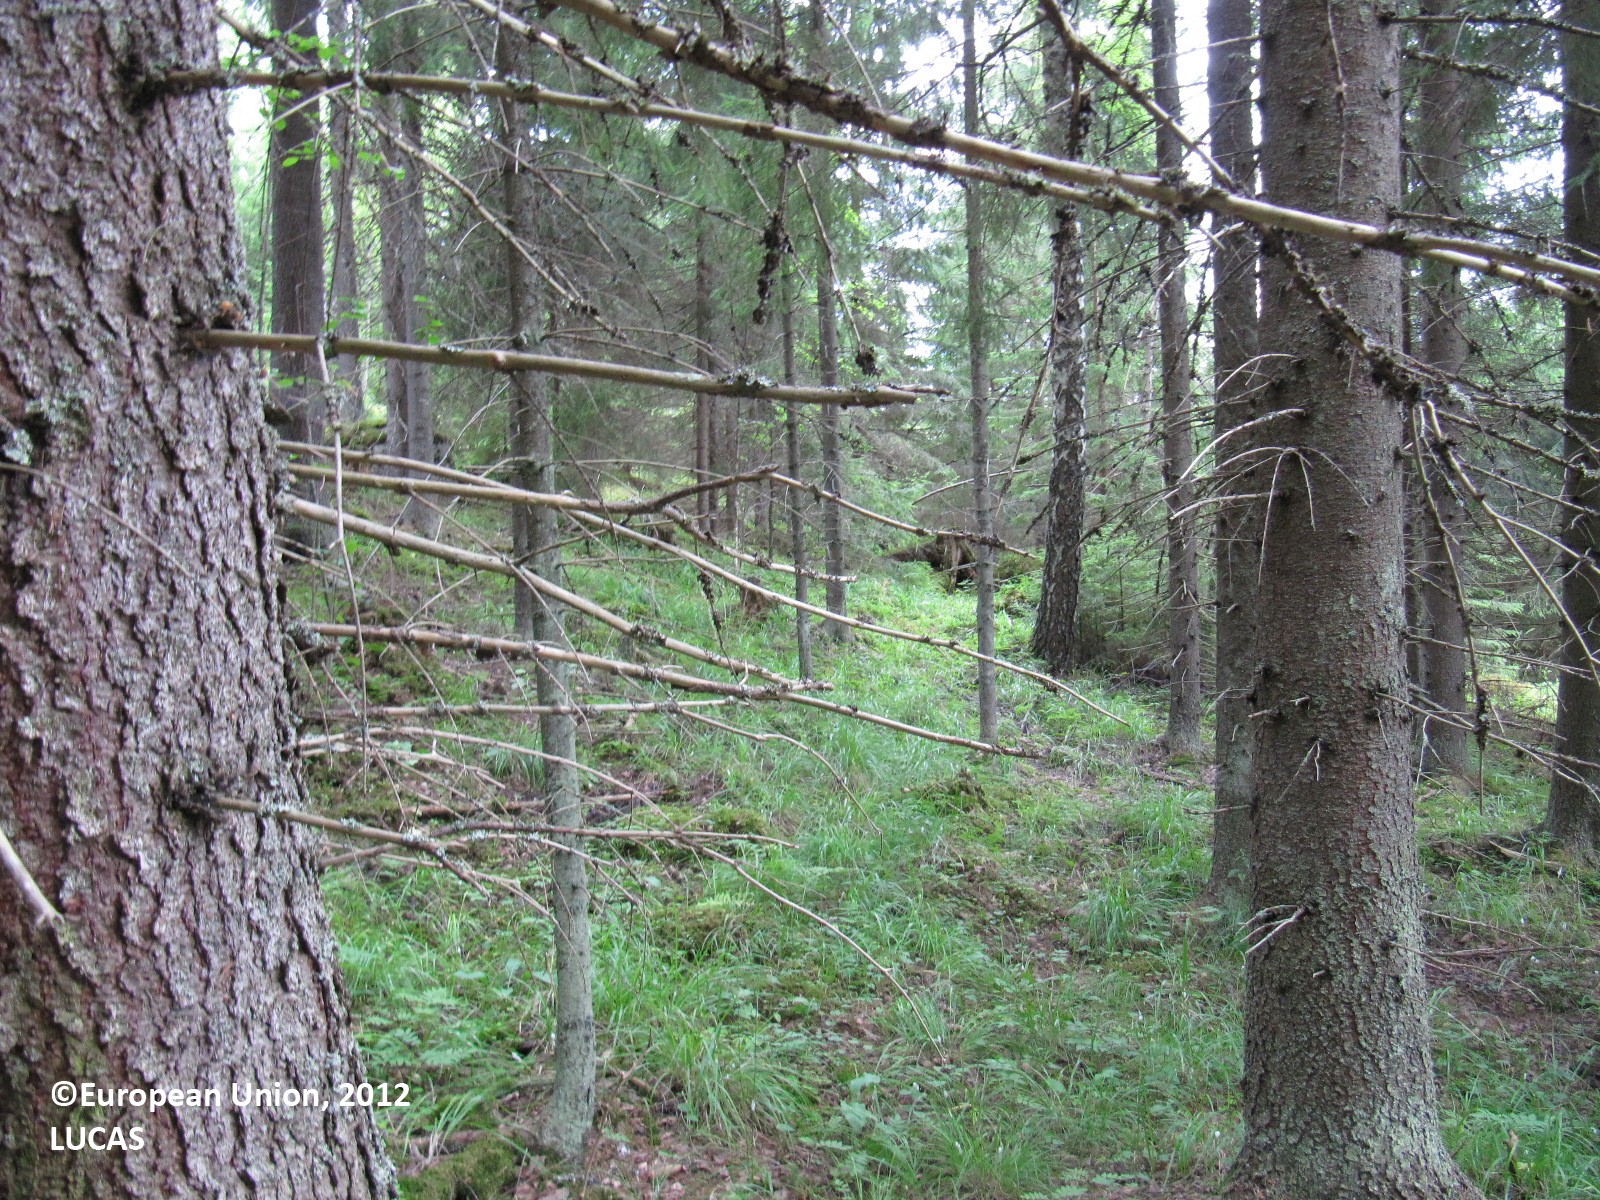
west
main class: Woodland
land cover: Spruce dominated mixed woodland
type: boreal forest
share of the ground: > 75 %
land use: Forestry
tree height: > 5 m
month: July
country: FI
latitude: 60.8309
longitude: 24.5810
